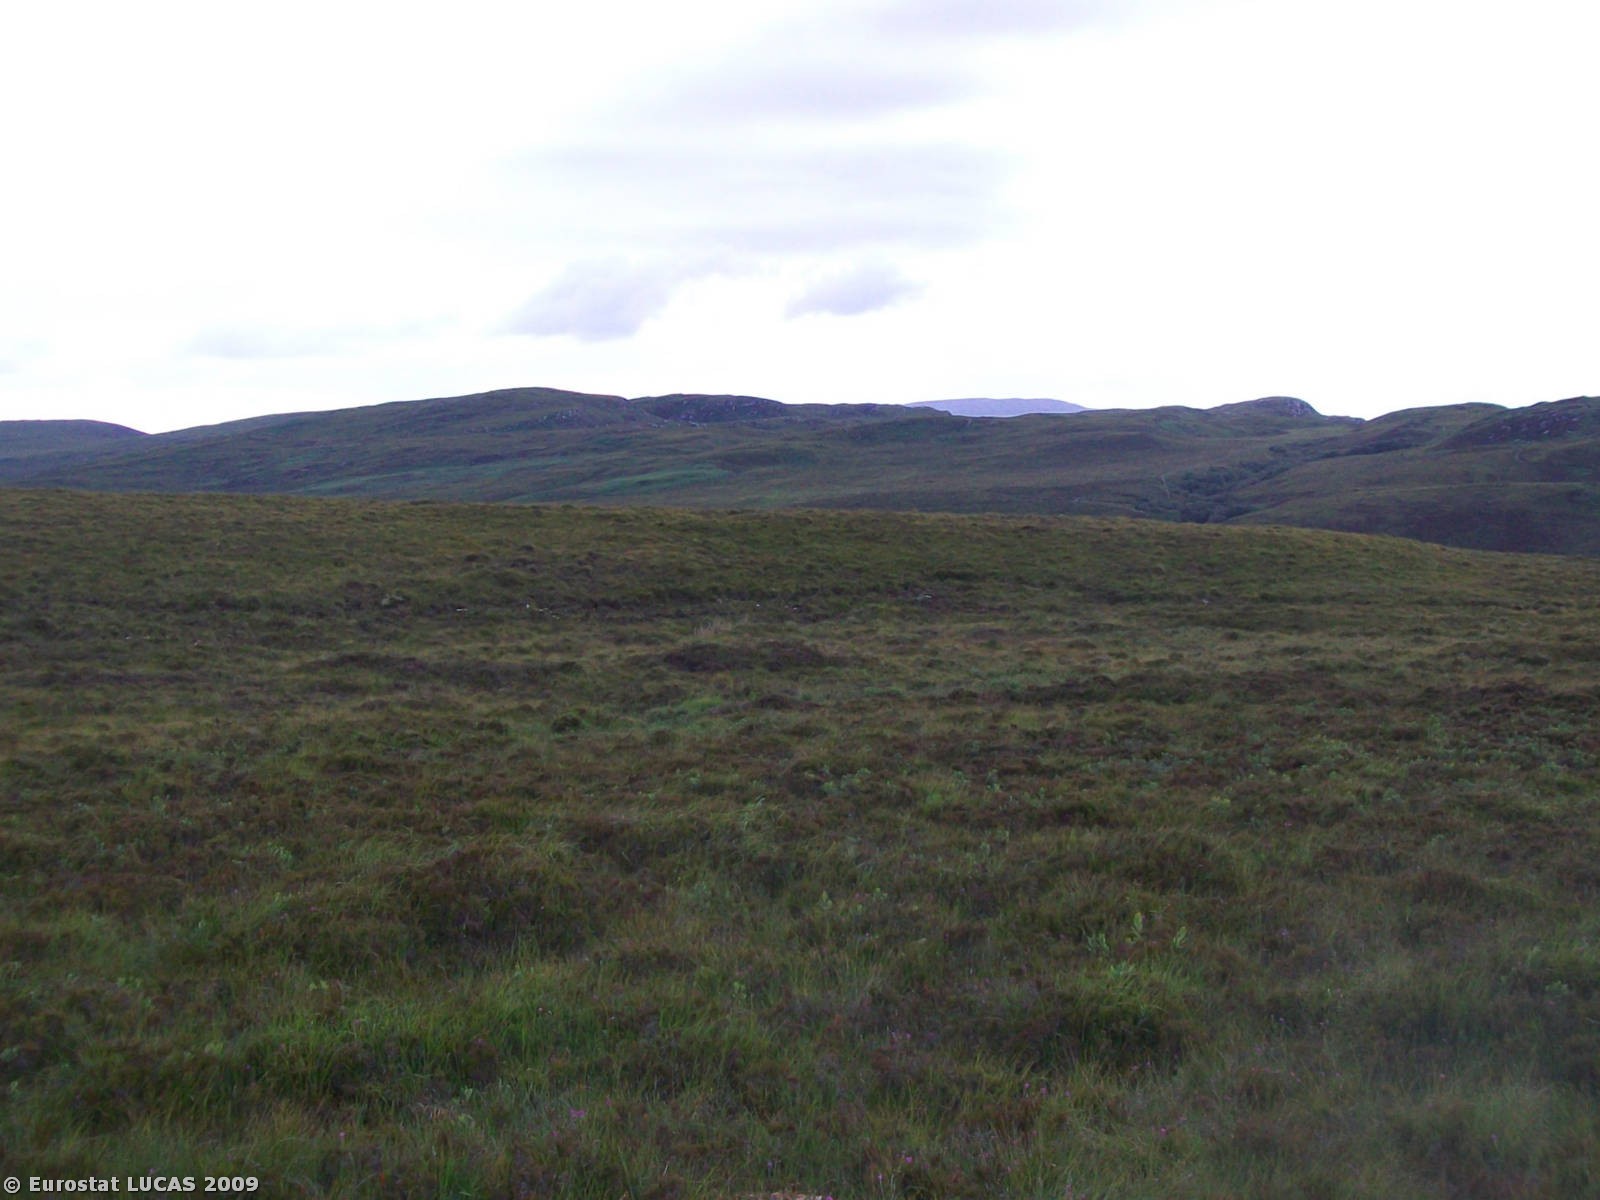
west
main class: Shrubland
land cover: Shrubland without tree cover
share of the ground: > 75 %
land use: Agriculture (excluding fallow land and kitchen gardens)
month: July
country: GB
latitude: 58.4779
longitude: -4.6124
